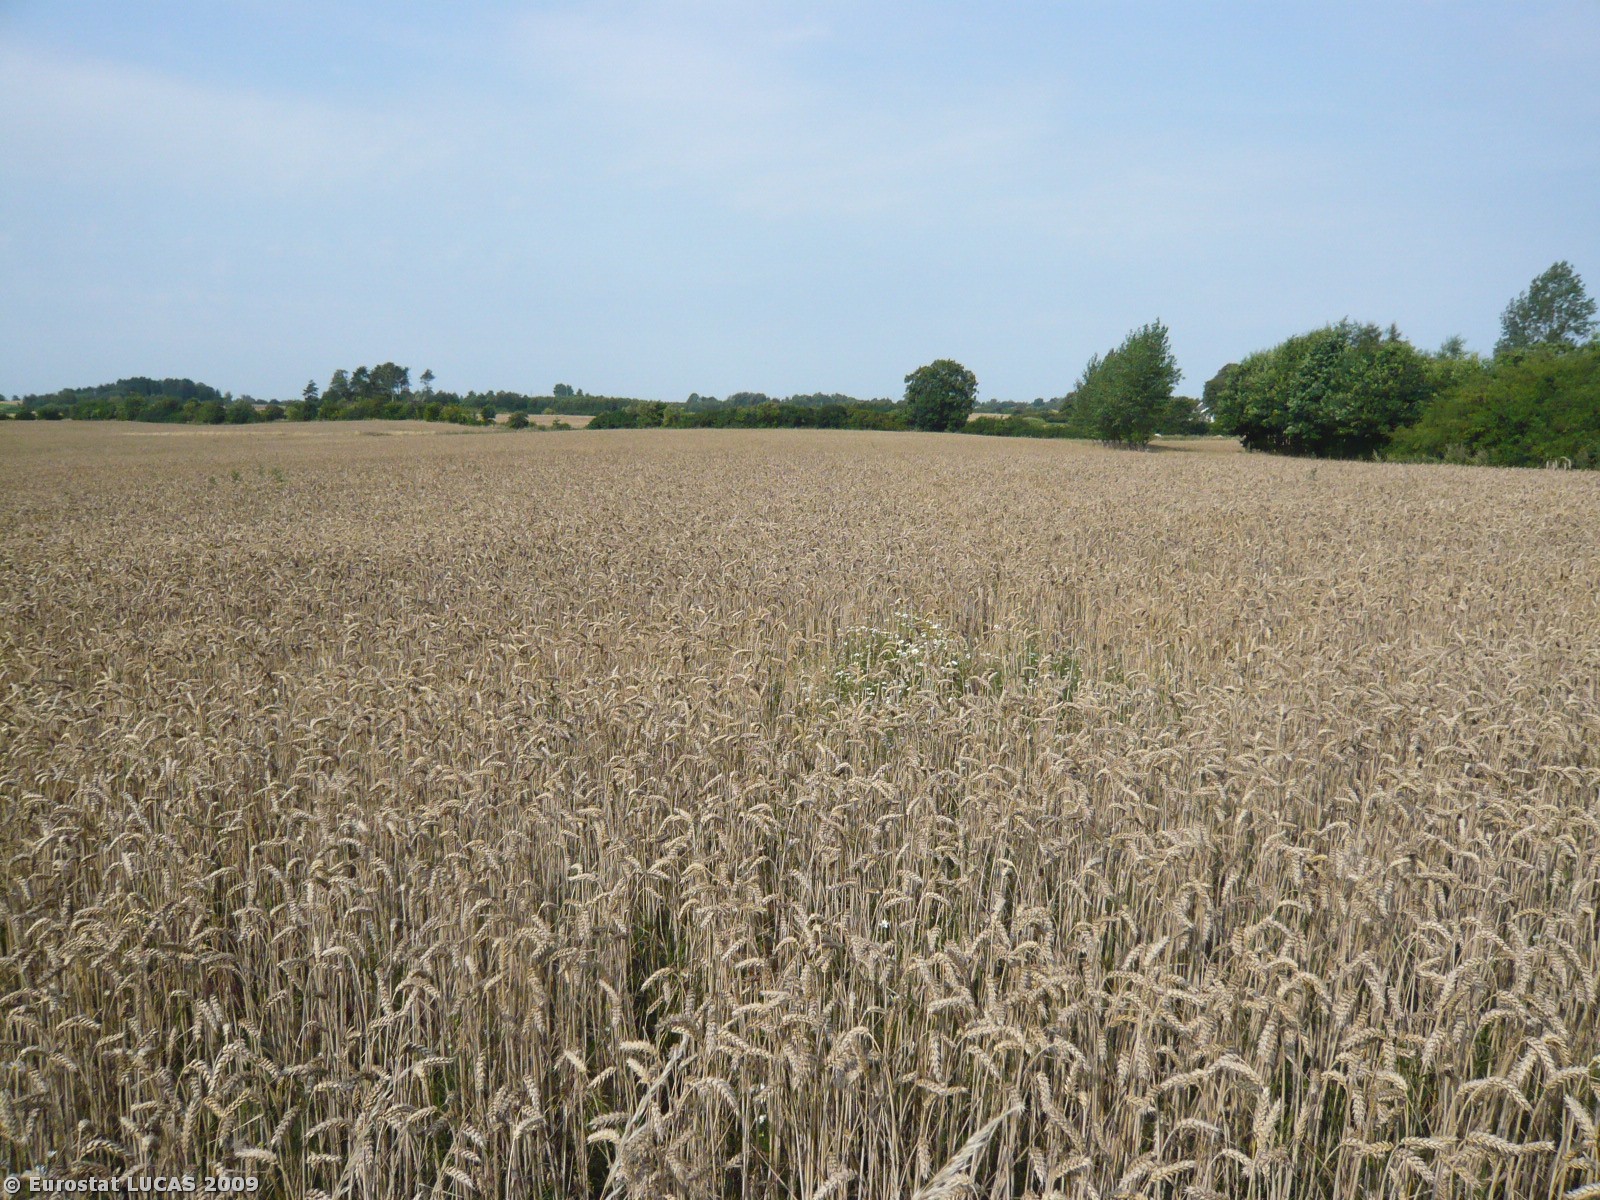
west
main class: Cropland
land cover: Common wheat
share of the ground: > 75 %
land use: Agriculture (excluding fallow land and kitchen gardens)
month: August
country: DK
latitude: 56.0072
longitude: 12.1951
